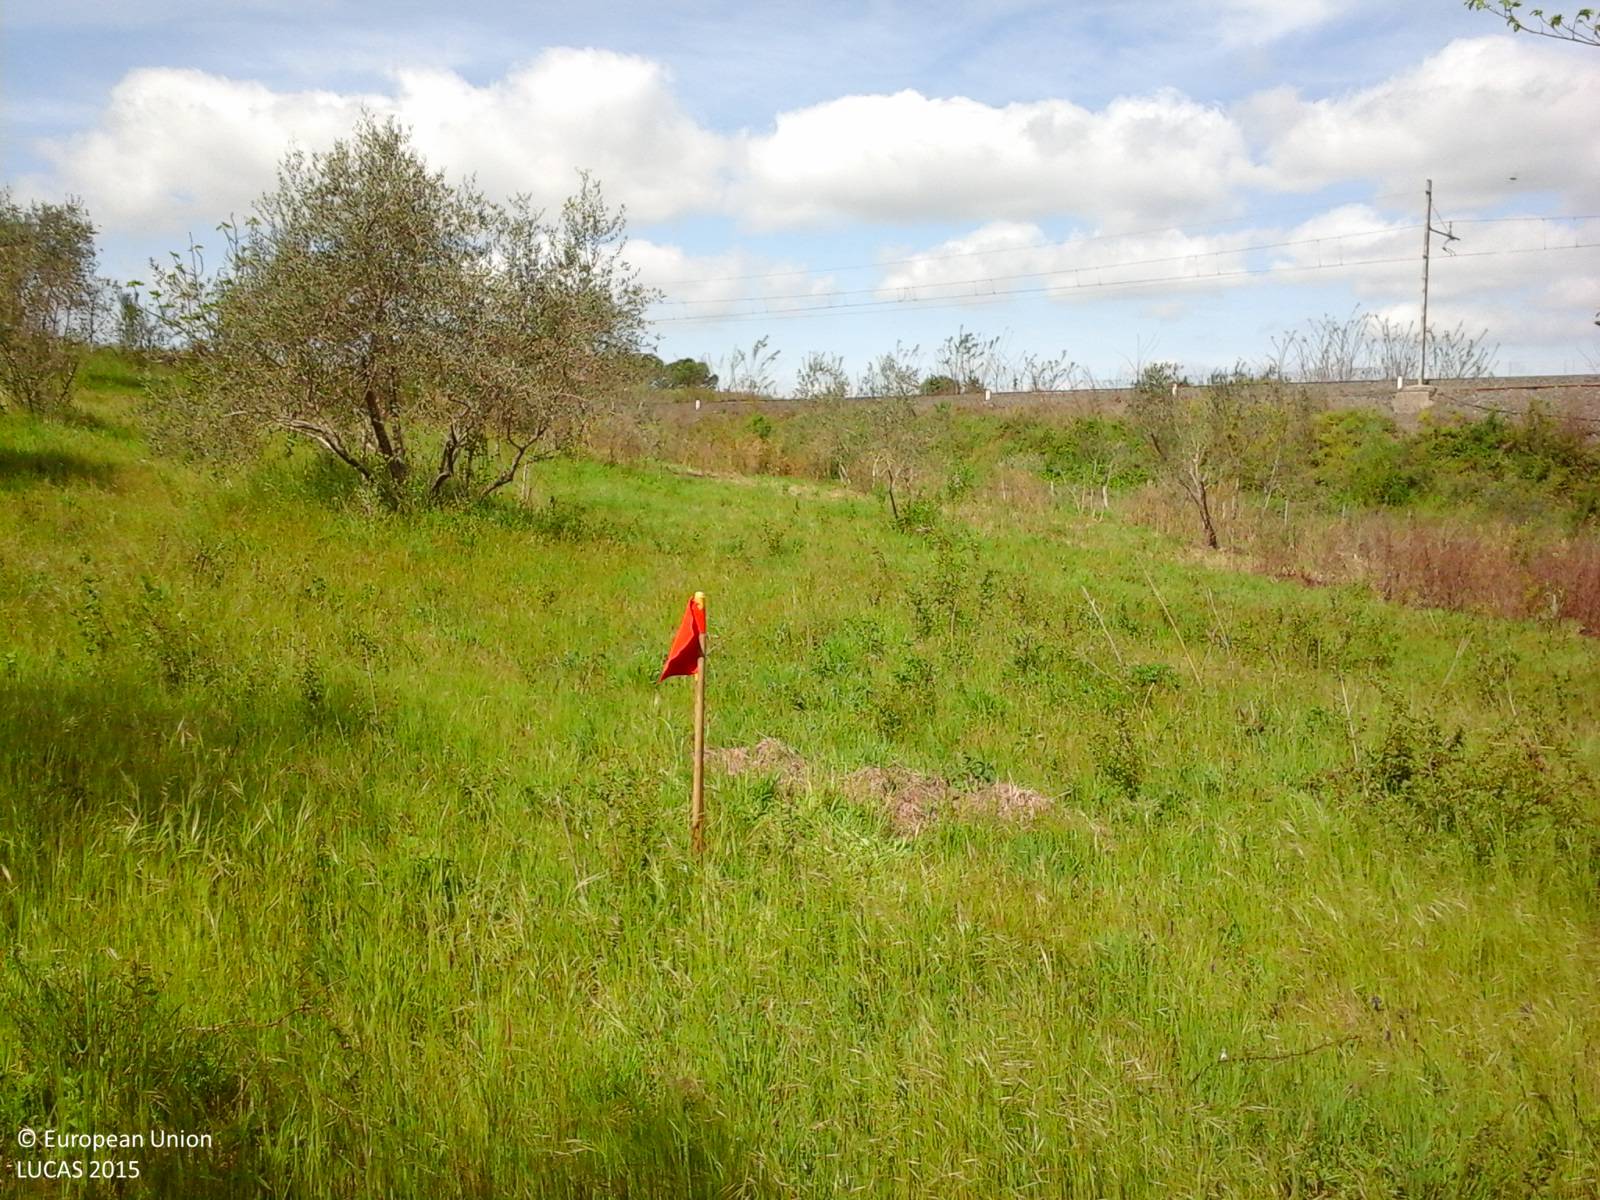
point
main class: Cropland
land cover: Olive groves
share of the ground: 25 - 50 %
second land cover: Grassland without tree/shrub cover
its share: > 75 %
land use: Agriculture (excluding fallow land and kitchen gardens)
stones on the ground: < 10 %
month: May
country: IT
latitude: 42.3614
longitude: 12.0933
